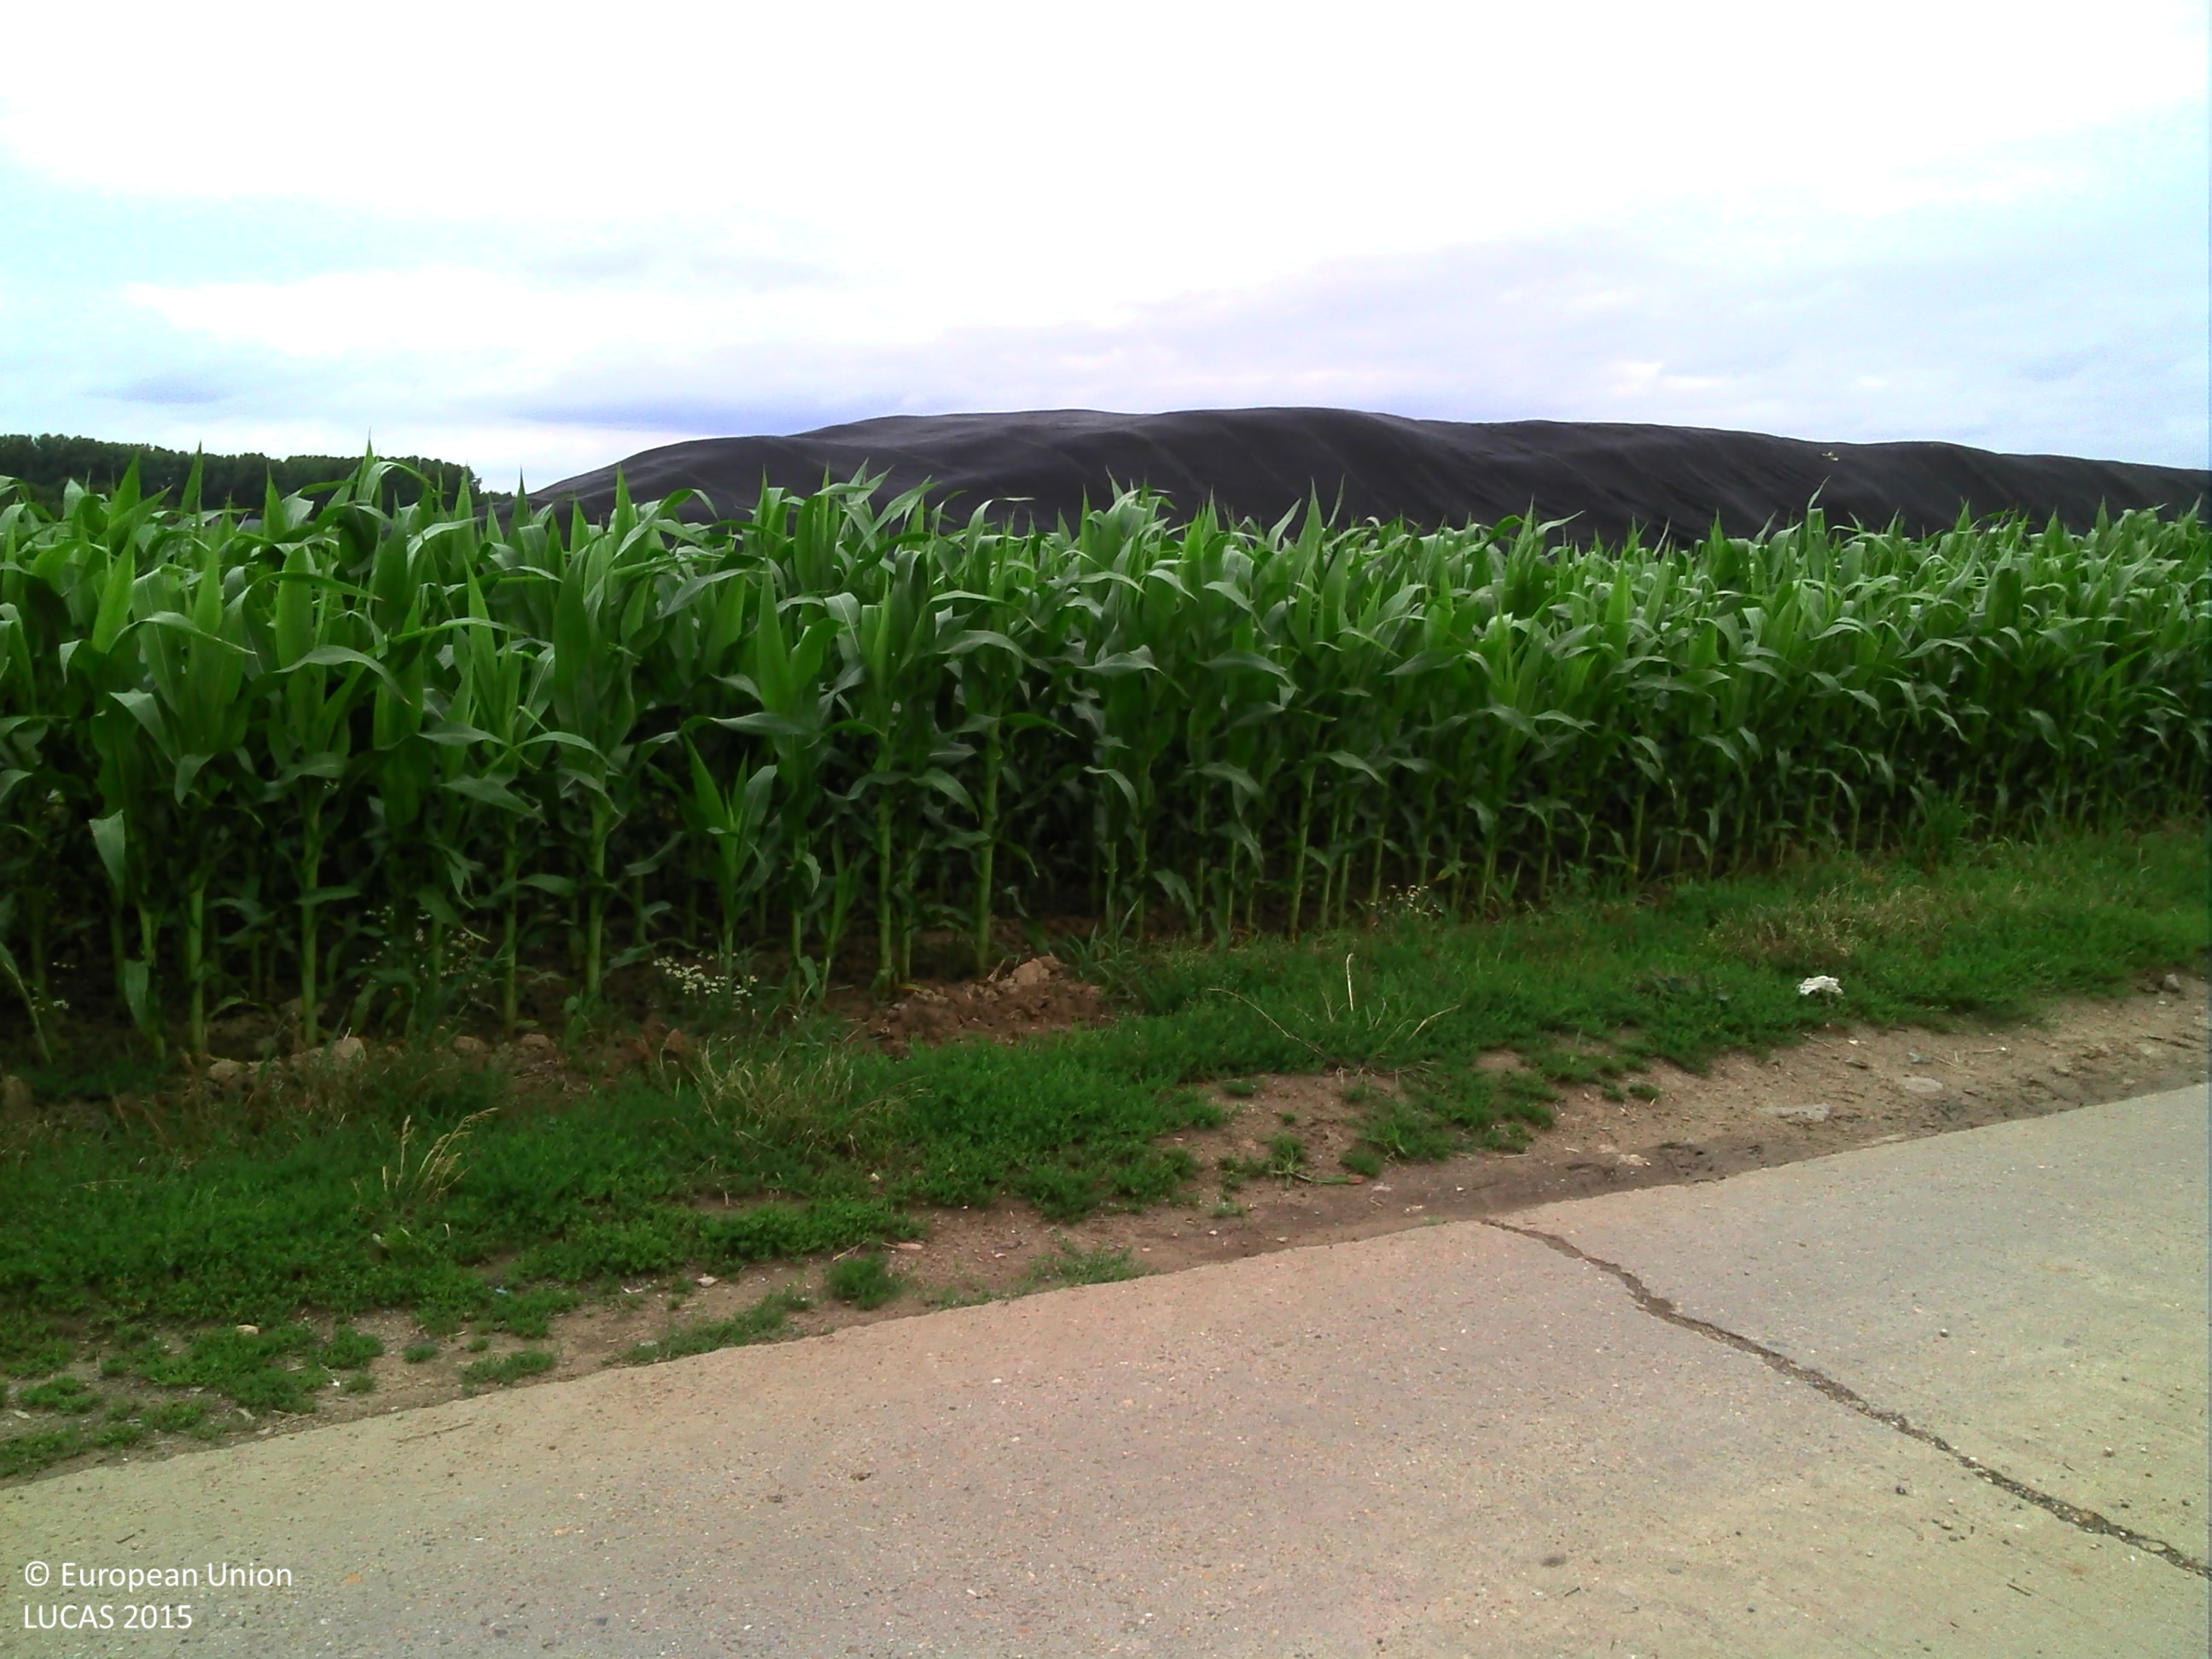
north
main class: Cropland
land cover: Maize
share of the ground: > 75 %
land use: Agriculture (excluding fallow land and kitchen gardens)
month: July
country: BE
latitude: 50.8494
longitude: 5.4387
